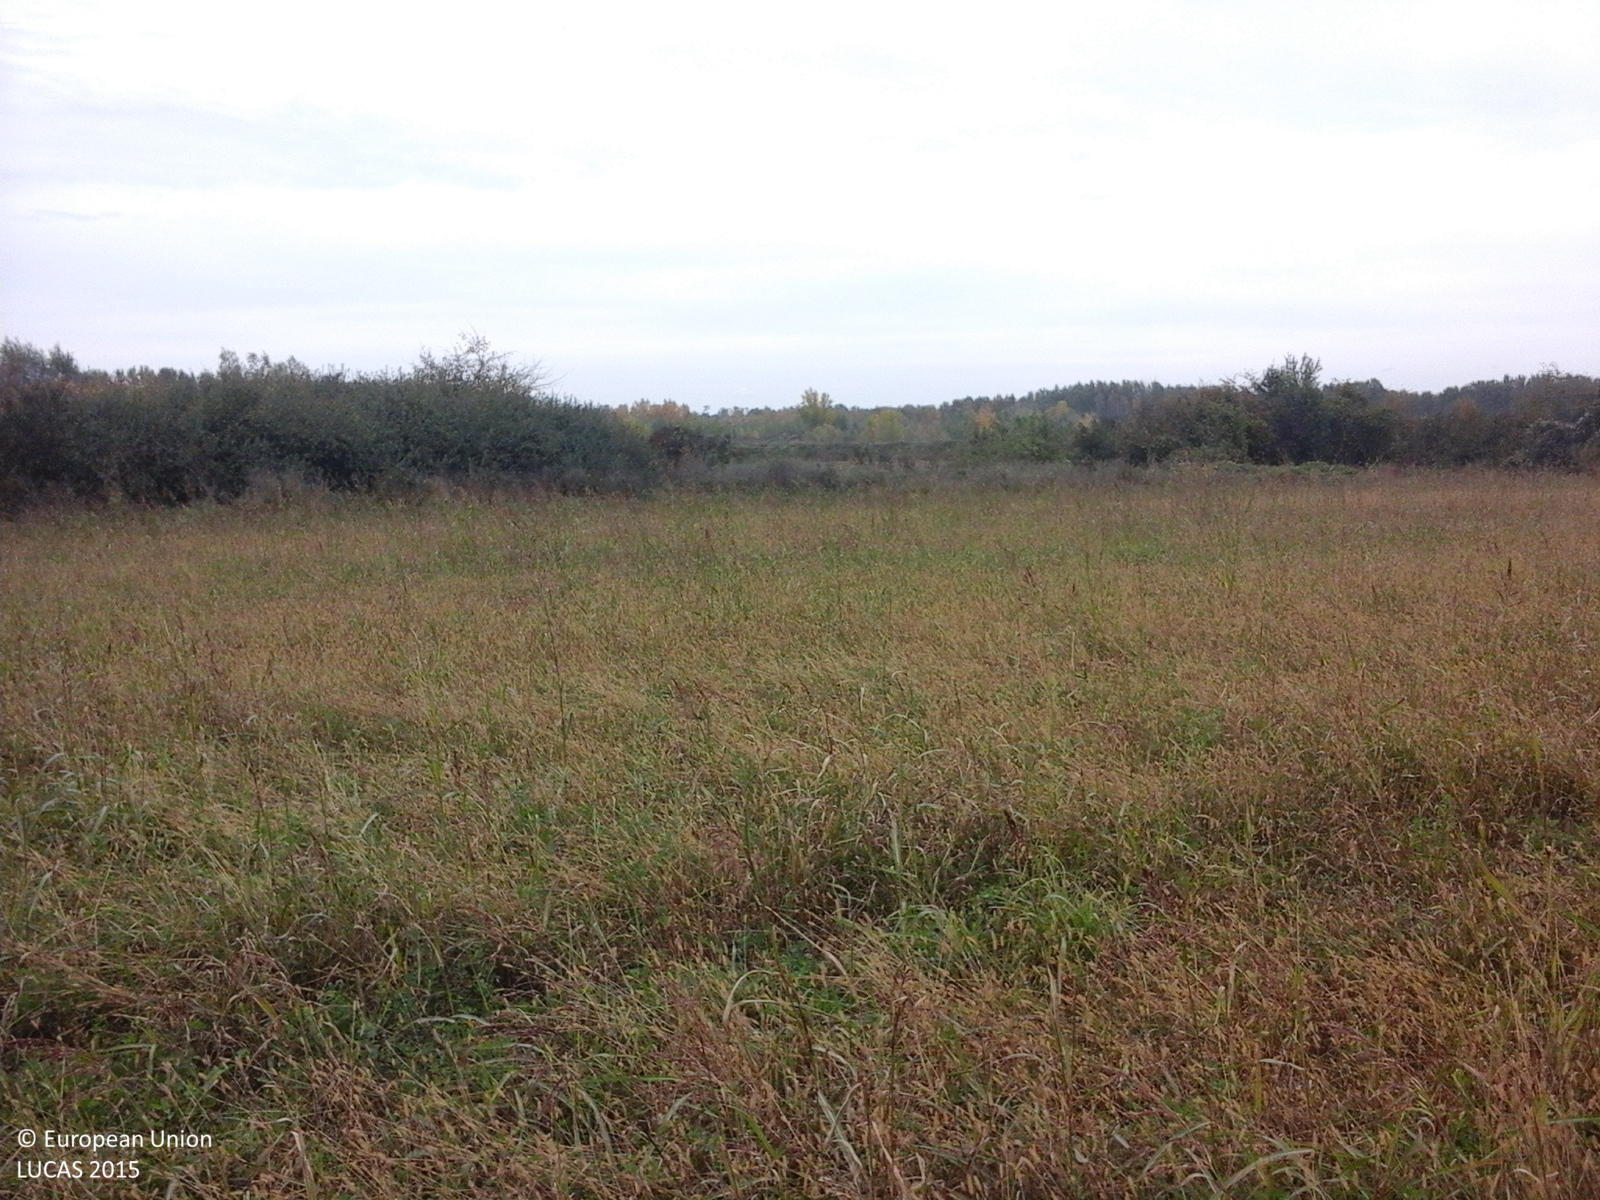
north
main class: Grassland
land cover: Spontaneously vegetated surfaces
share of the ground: > 75 %
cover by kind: herbaceous plants 100 %
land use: Fallow land
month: October
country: RO
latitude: 44.7990
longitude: 26.0487
